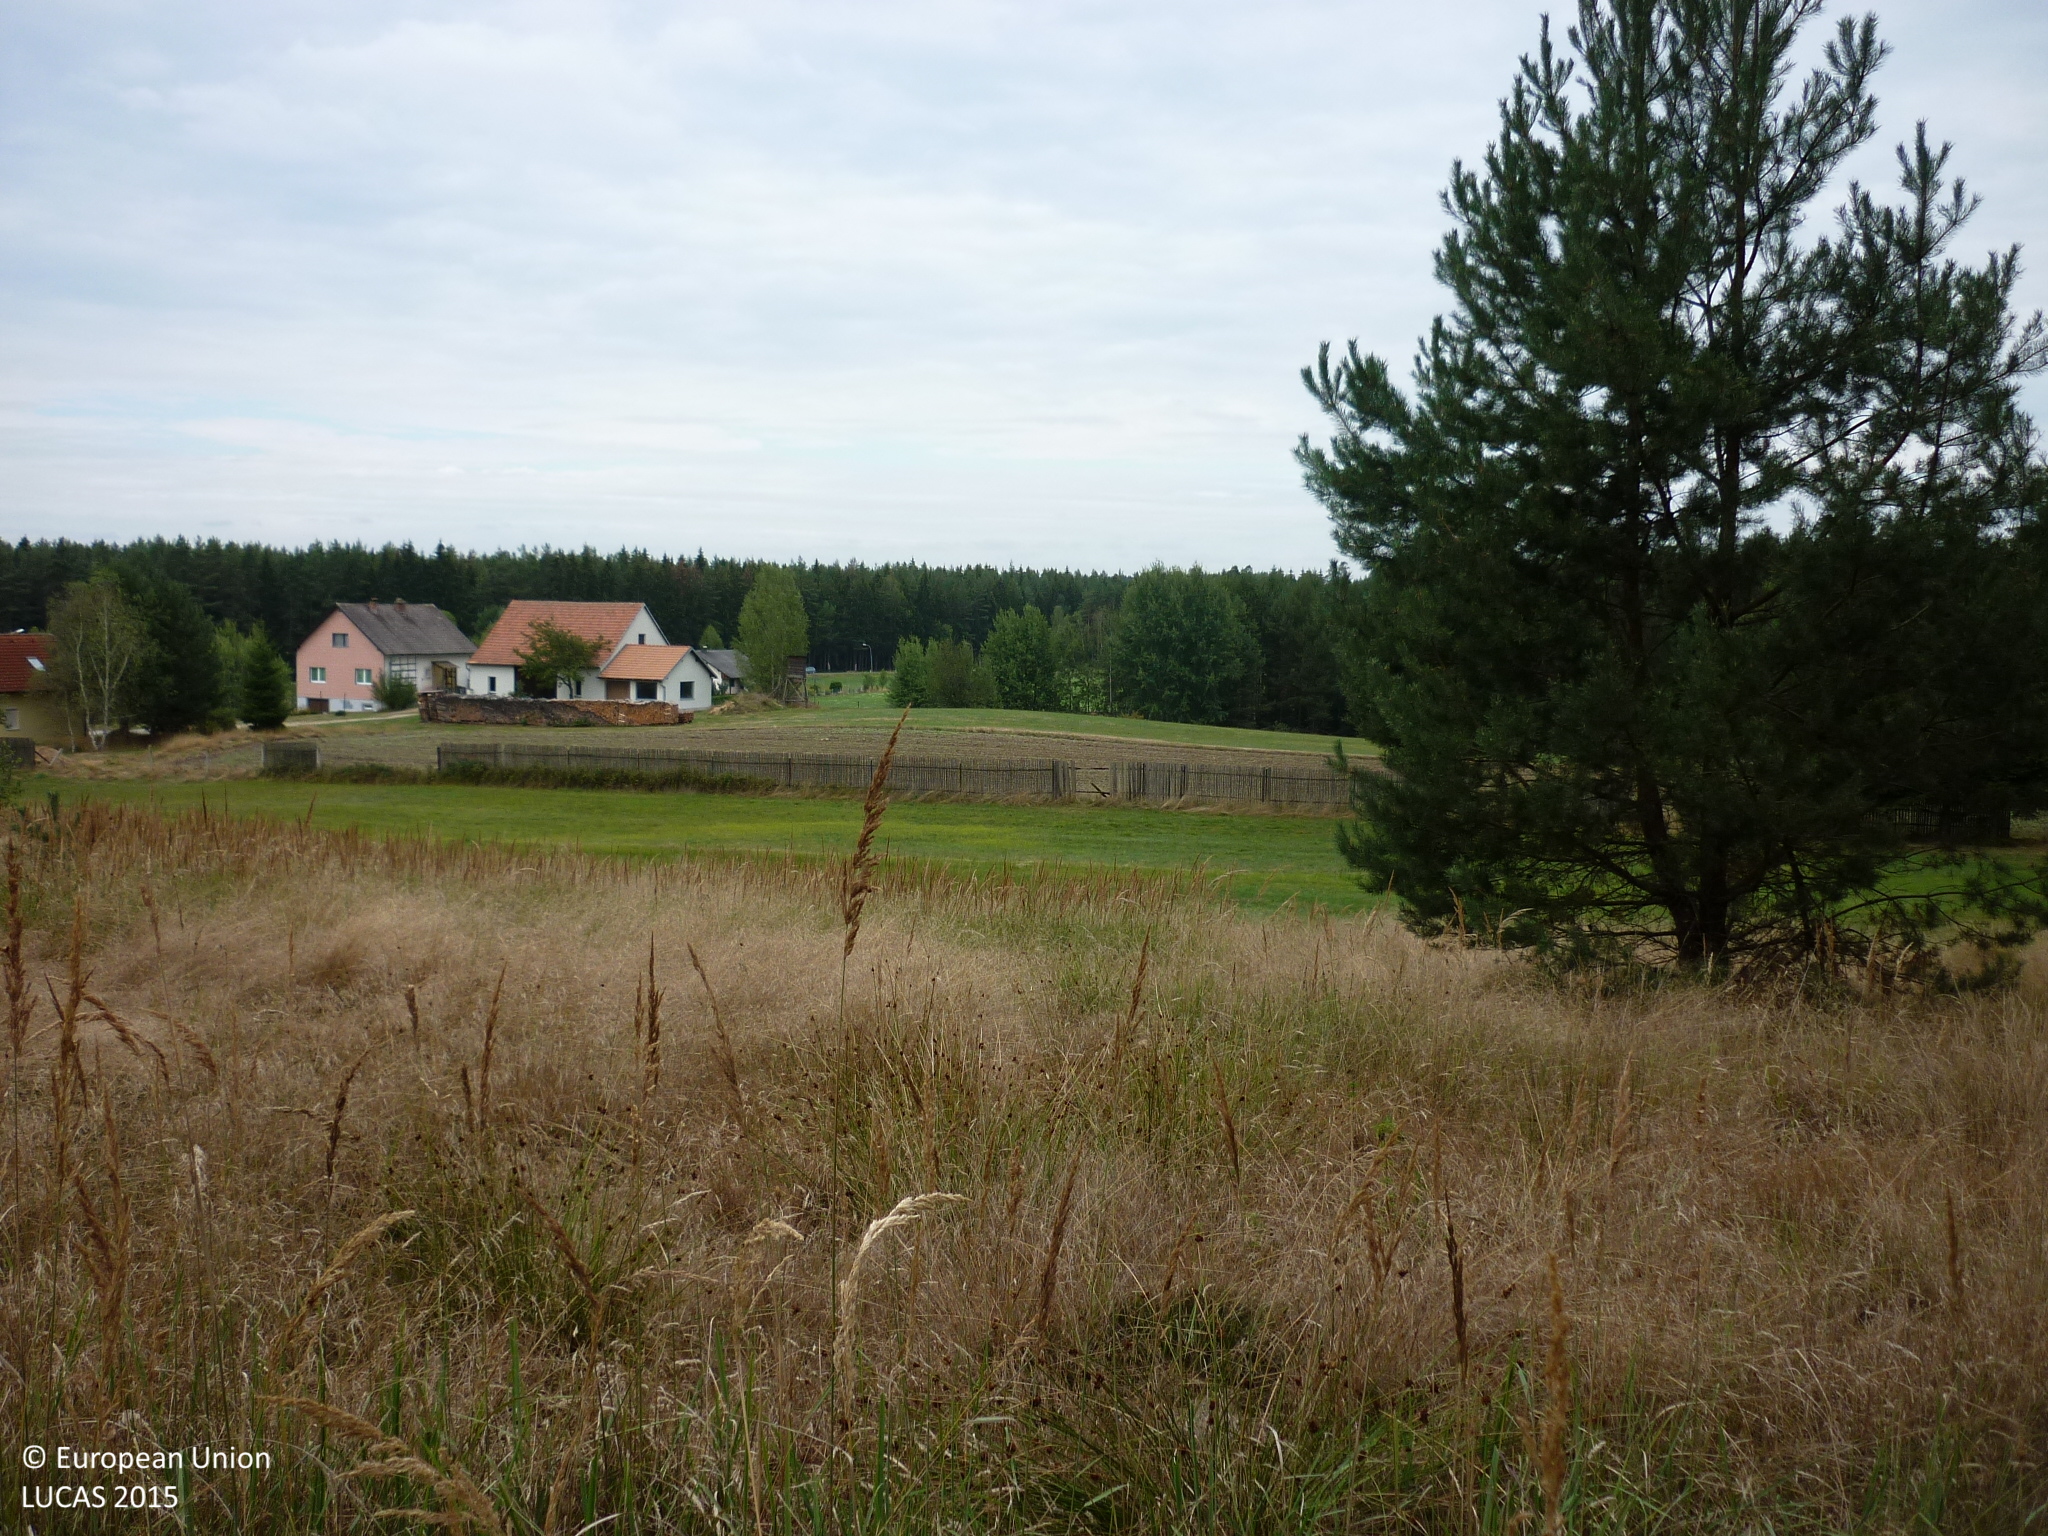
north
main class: Grassland
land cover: Grassland with sparse tree/shrub cover
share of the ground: > 75 %
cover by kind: herbaceous plants 95 %, coniferous forest trees 5 %
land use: Semi-natural and natural areas not in use
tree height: > 5 m
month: September
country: AT
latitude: 48.8491
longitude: 15.0033
